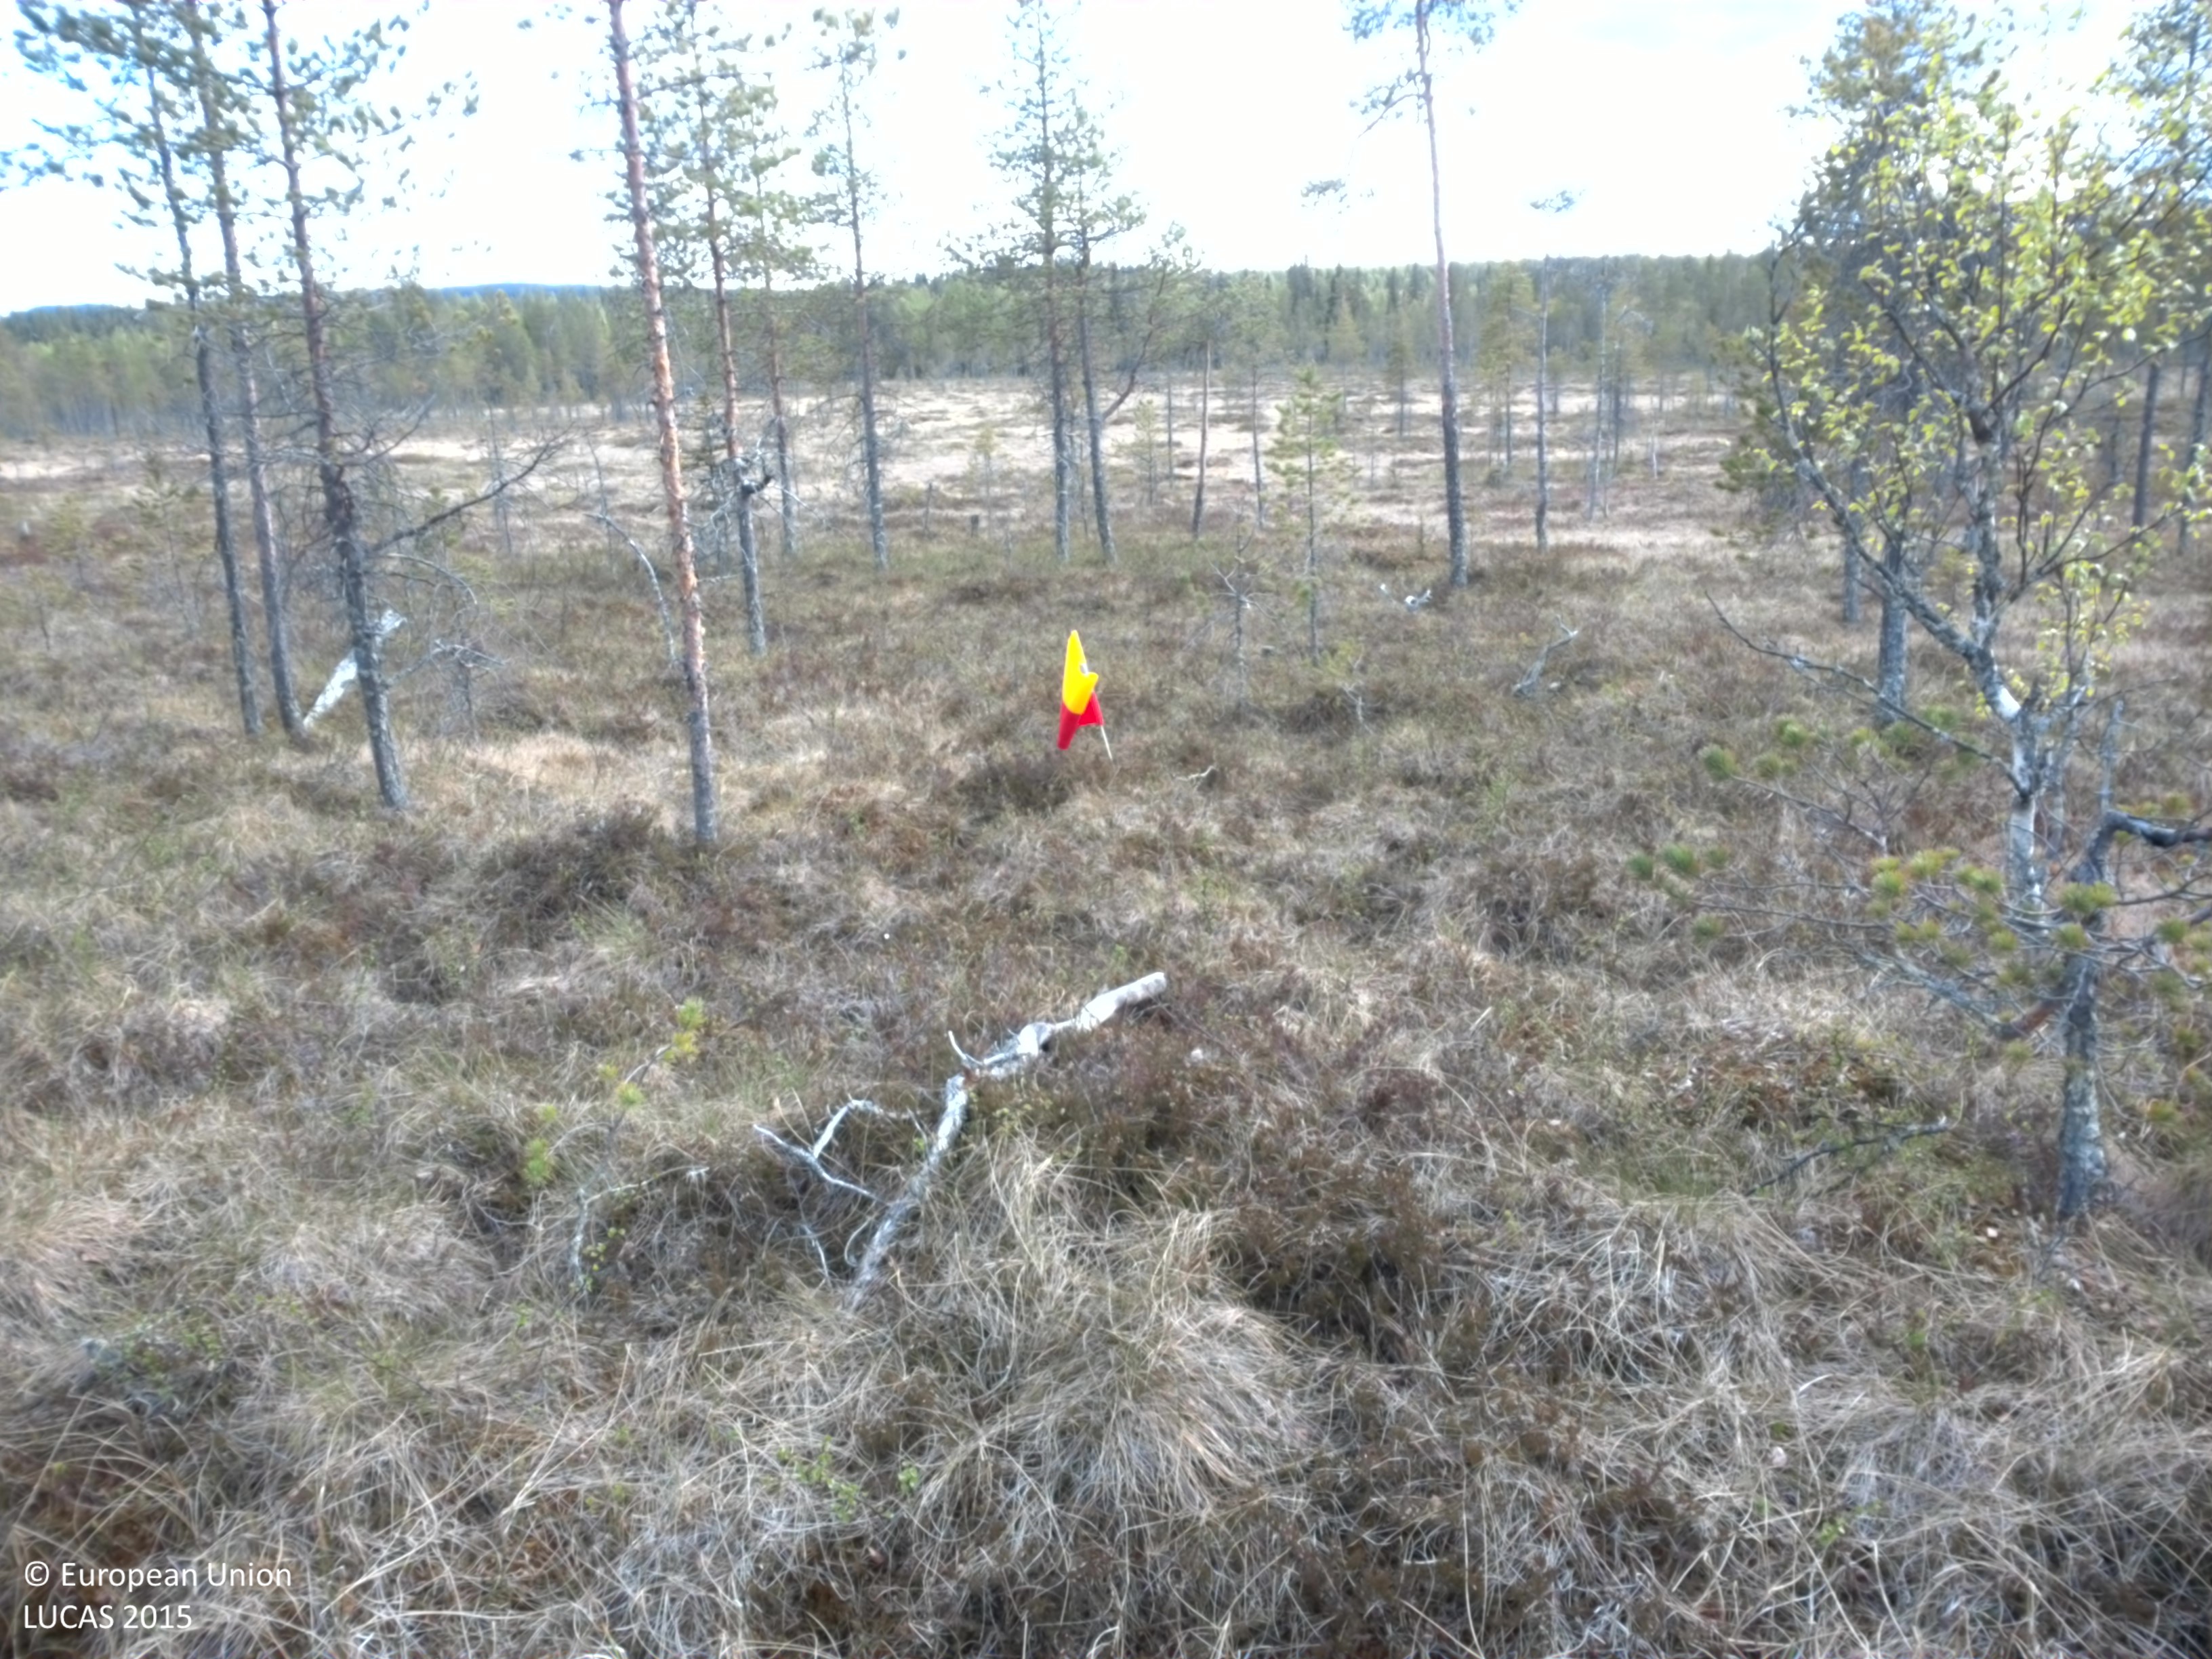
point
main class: Woodland
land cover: Pine dominated coniferous woodland
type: boreal forest
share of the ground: 25 - 50 %
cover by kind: herbaceous plants 45 %, coniferous forest trees 20 %, shrubs 15 %, lichens and mosses 10 %, broadleaved forest trees 5 %, unconsolidated bare surface 5 %
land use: Forestry
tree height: < 5 m
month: June
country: SE
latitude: 64.2052
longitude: 17.4459
